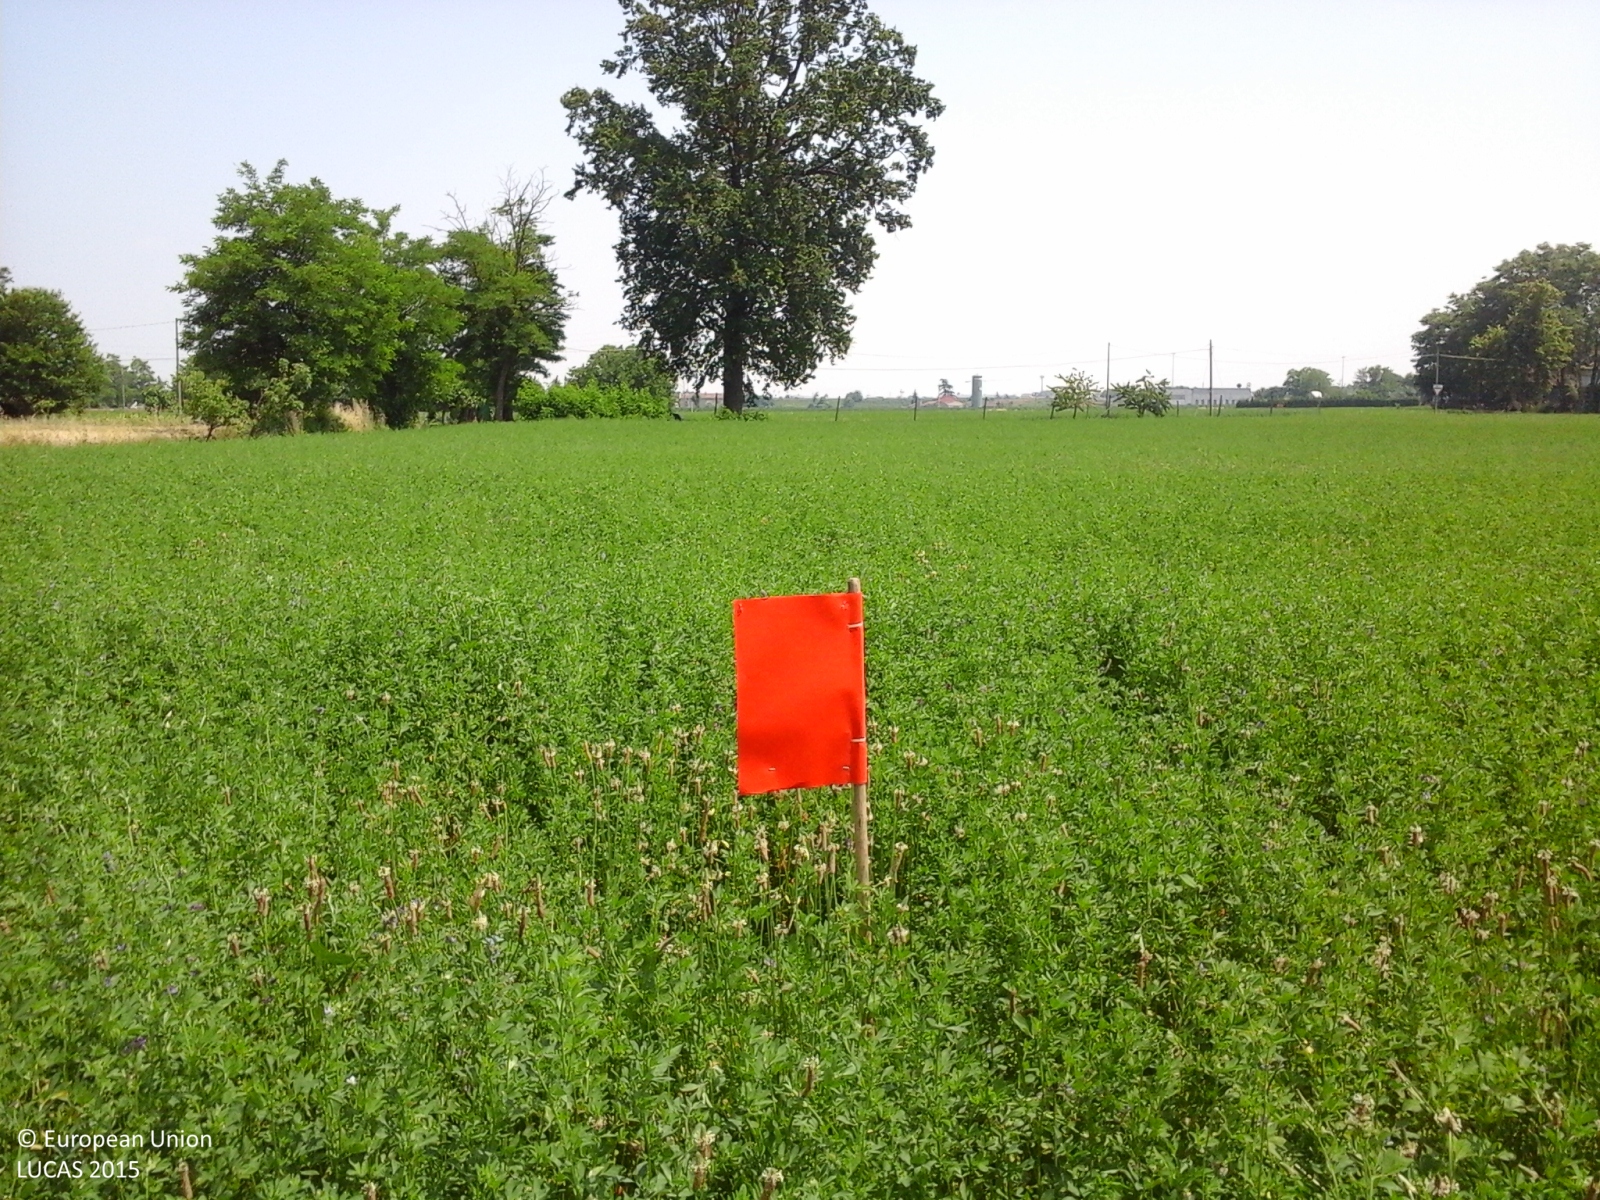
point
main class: Cropland
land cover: Lucerne
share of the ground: > 75 %
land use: Agriculture (excluding fallow land and kitchen gardens)
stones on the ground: < 10 %
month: June
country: IT
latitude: 44.9456
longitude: 9.8862
